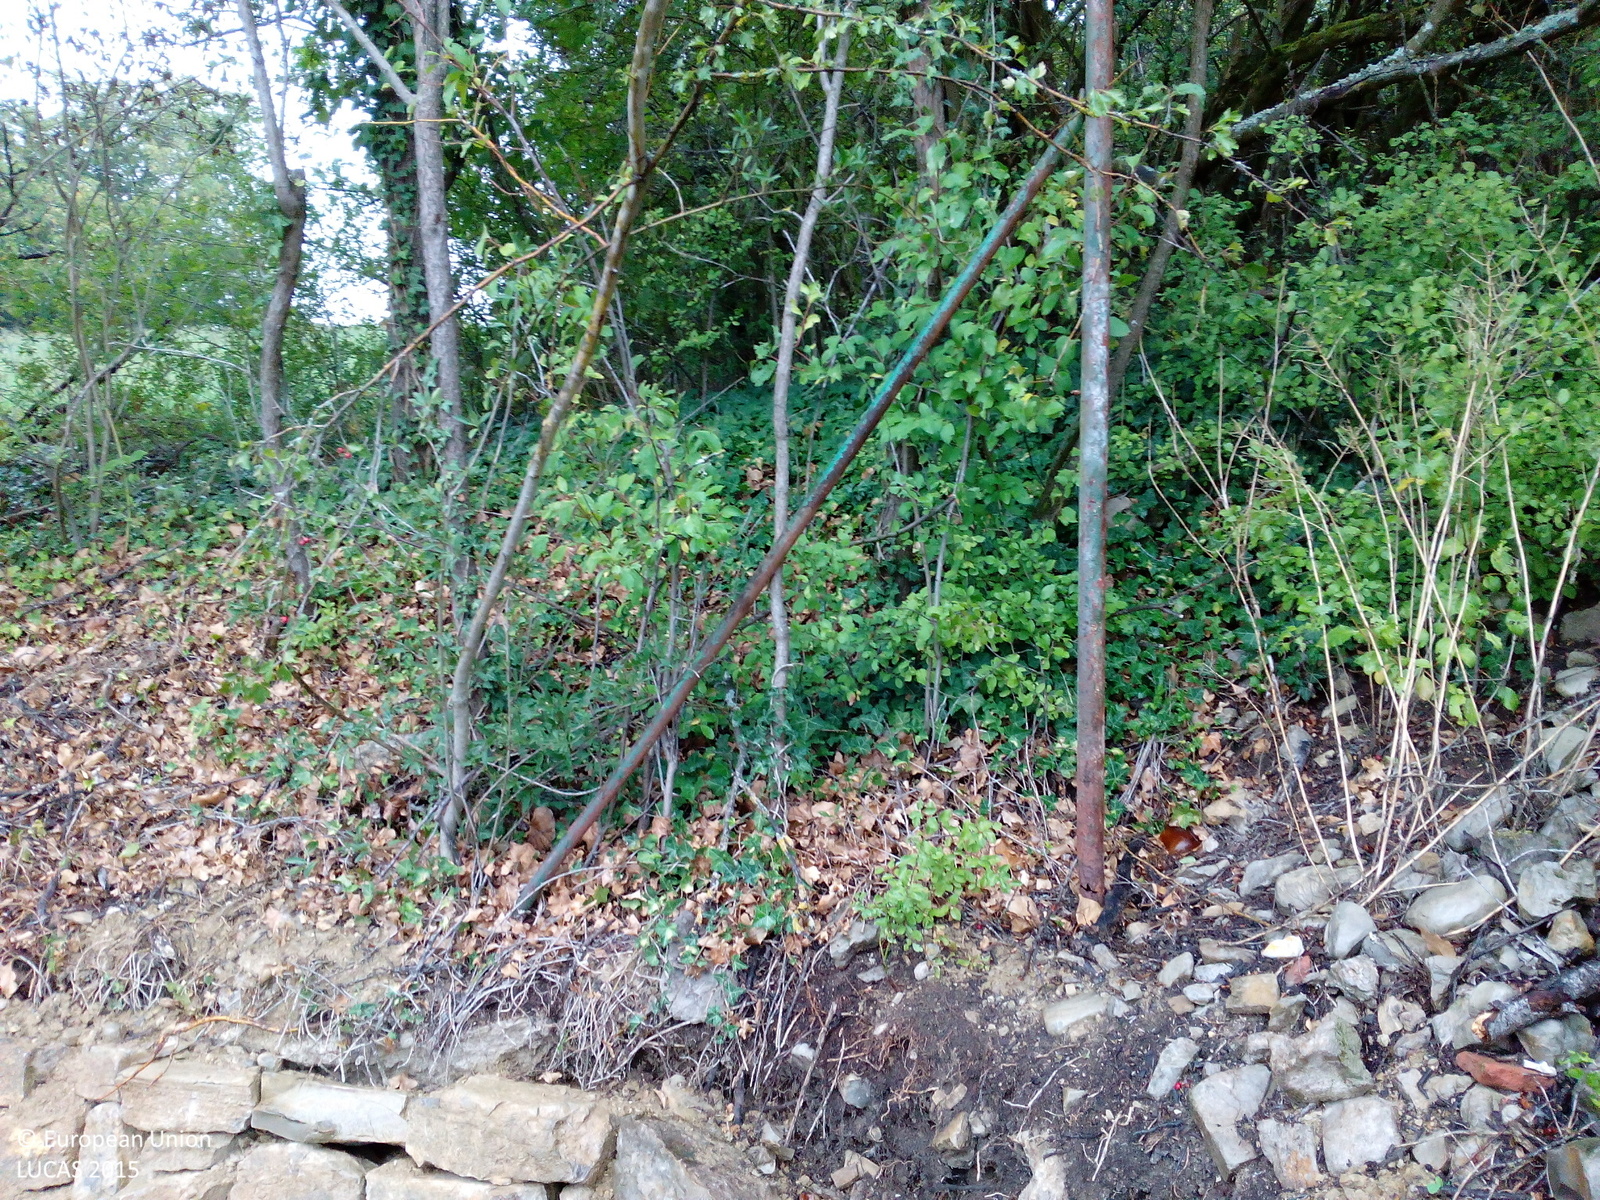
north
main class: Shrubland
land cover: Shrubland with sparse tree cover
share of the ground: > 75 %
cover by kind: shrubs 95 %, broadleaved forest trees 5 %
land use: Residential
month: September
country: DE
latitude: 49.8245
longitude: 9.9305
